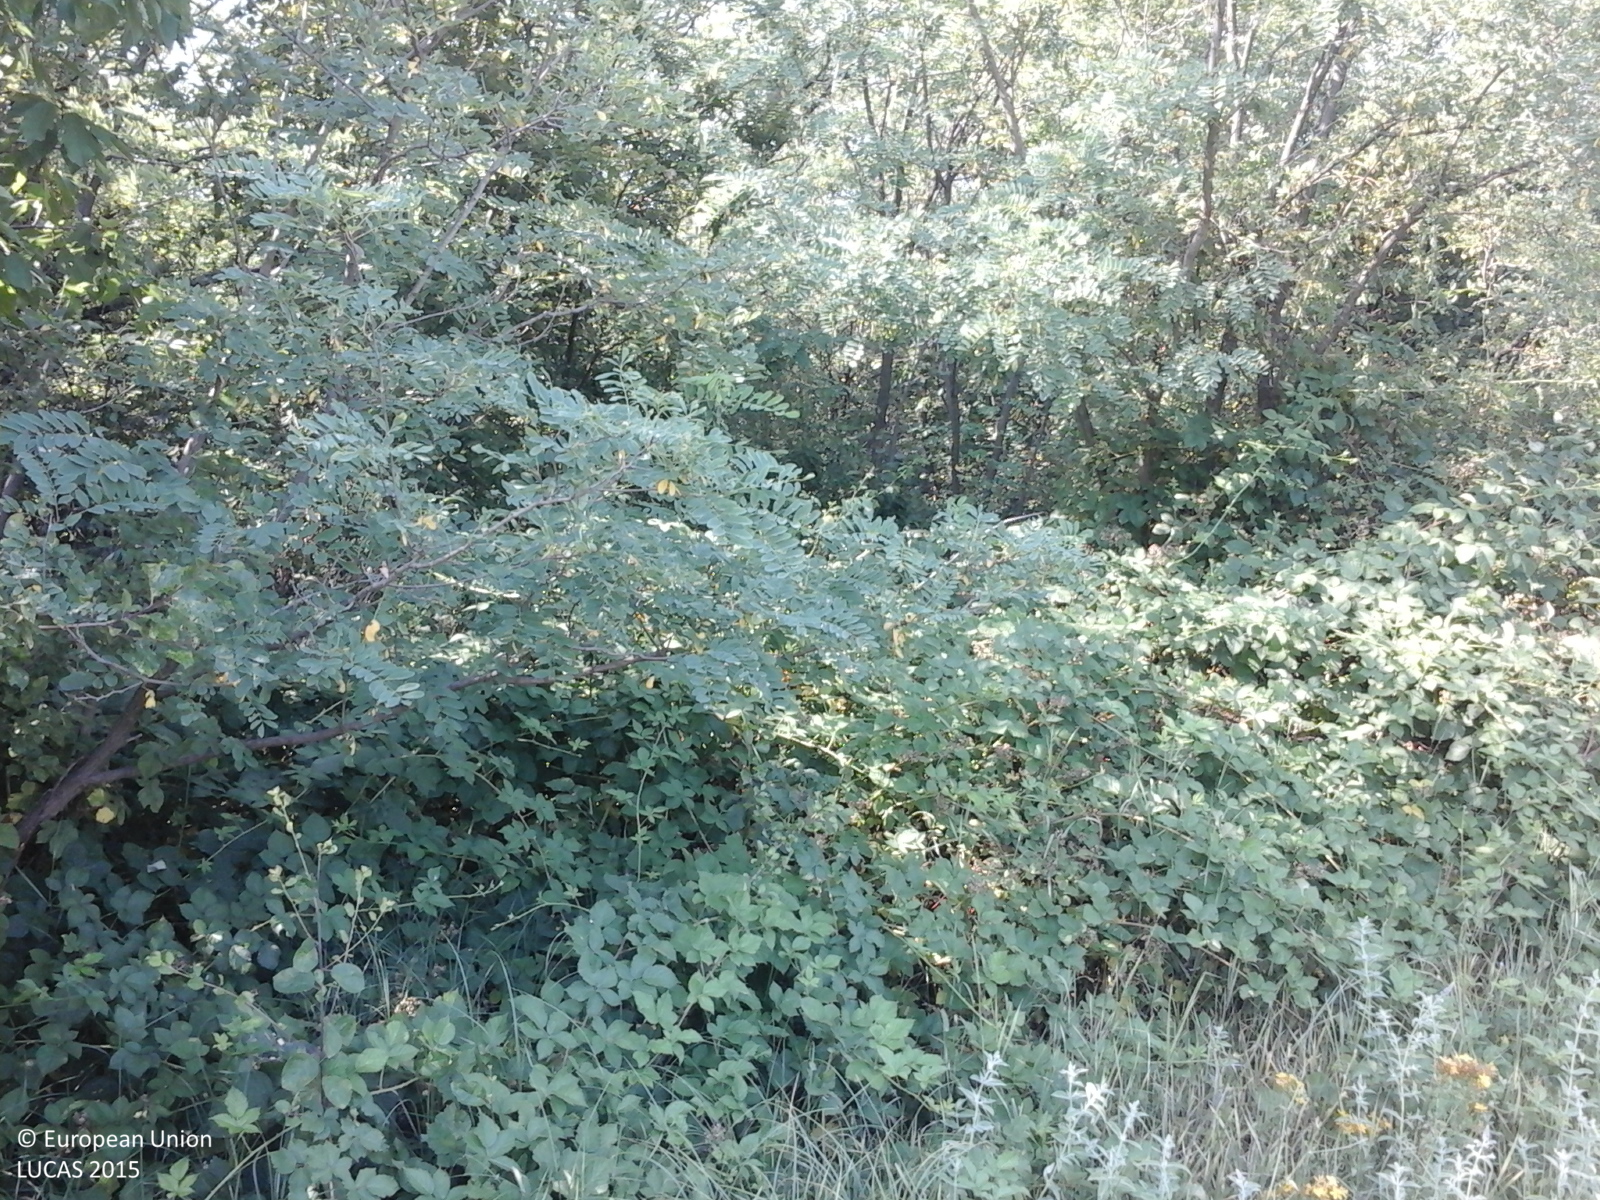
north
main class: Grassland
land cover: Spontaneously vegetated surfaces
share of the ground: > 75 %
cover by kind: herbaceous plants 100 %
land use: Agriculture (excluding fallow land and kitchen gardens)
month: July
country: RO
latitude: 44.7693
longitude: 24.6447
